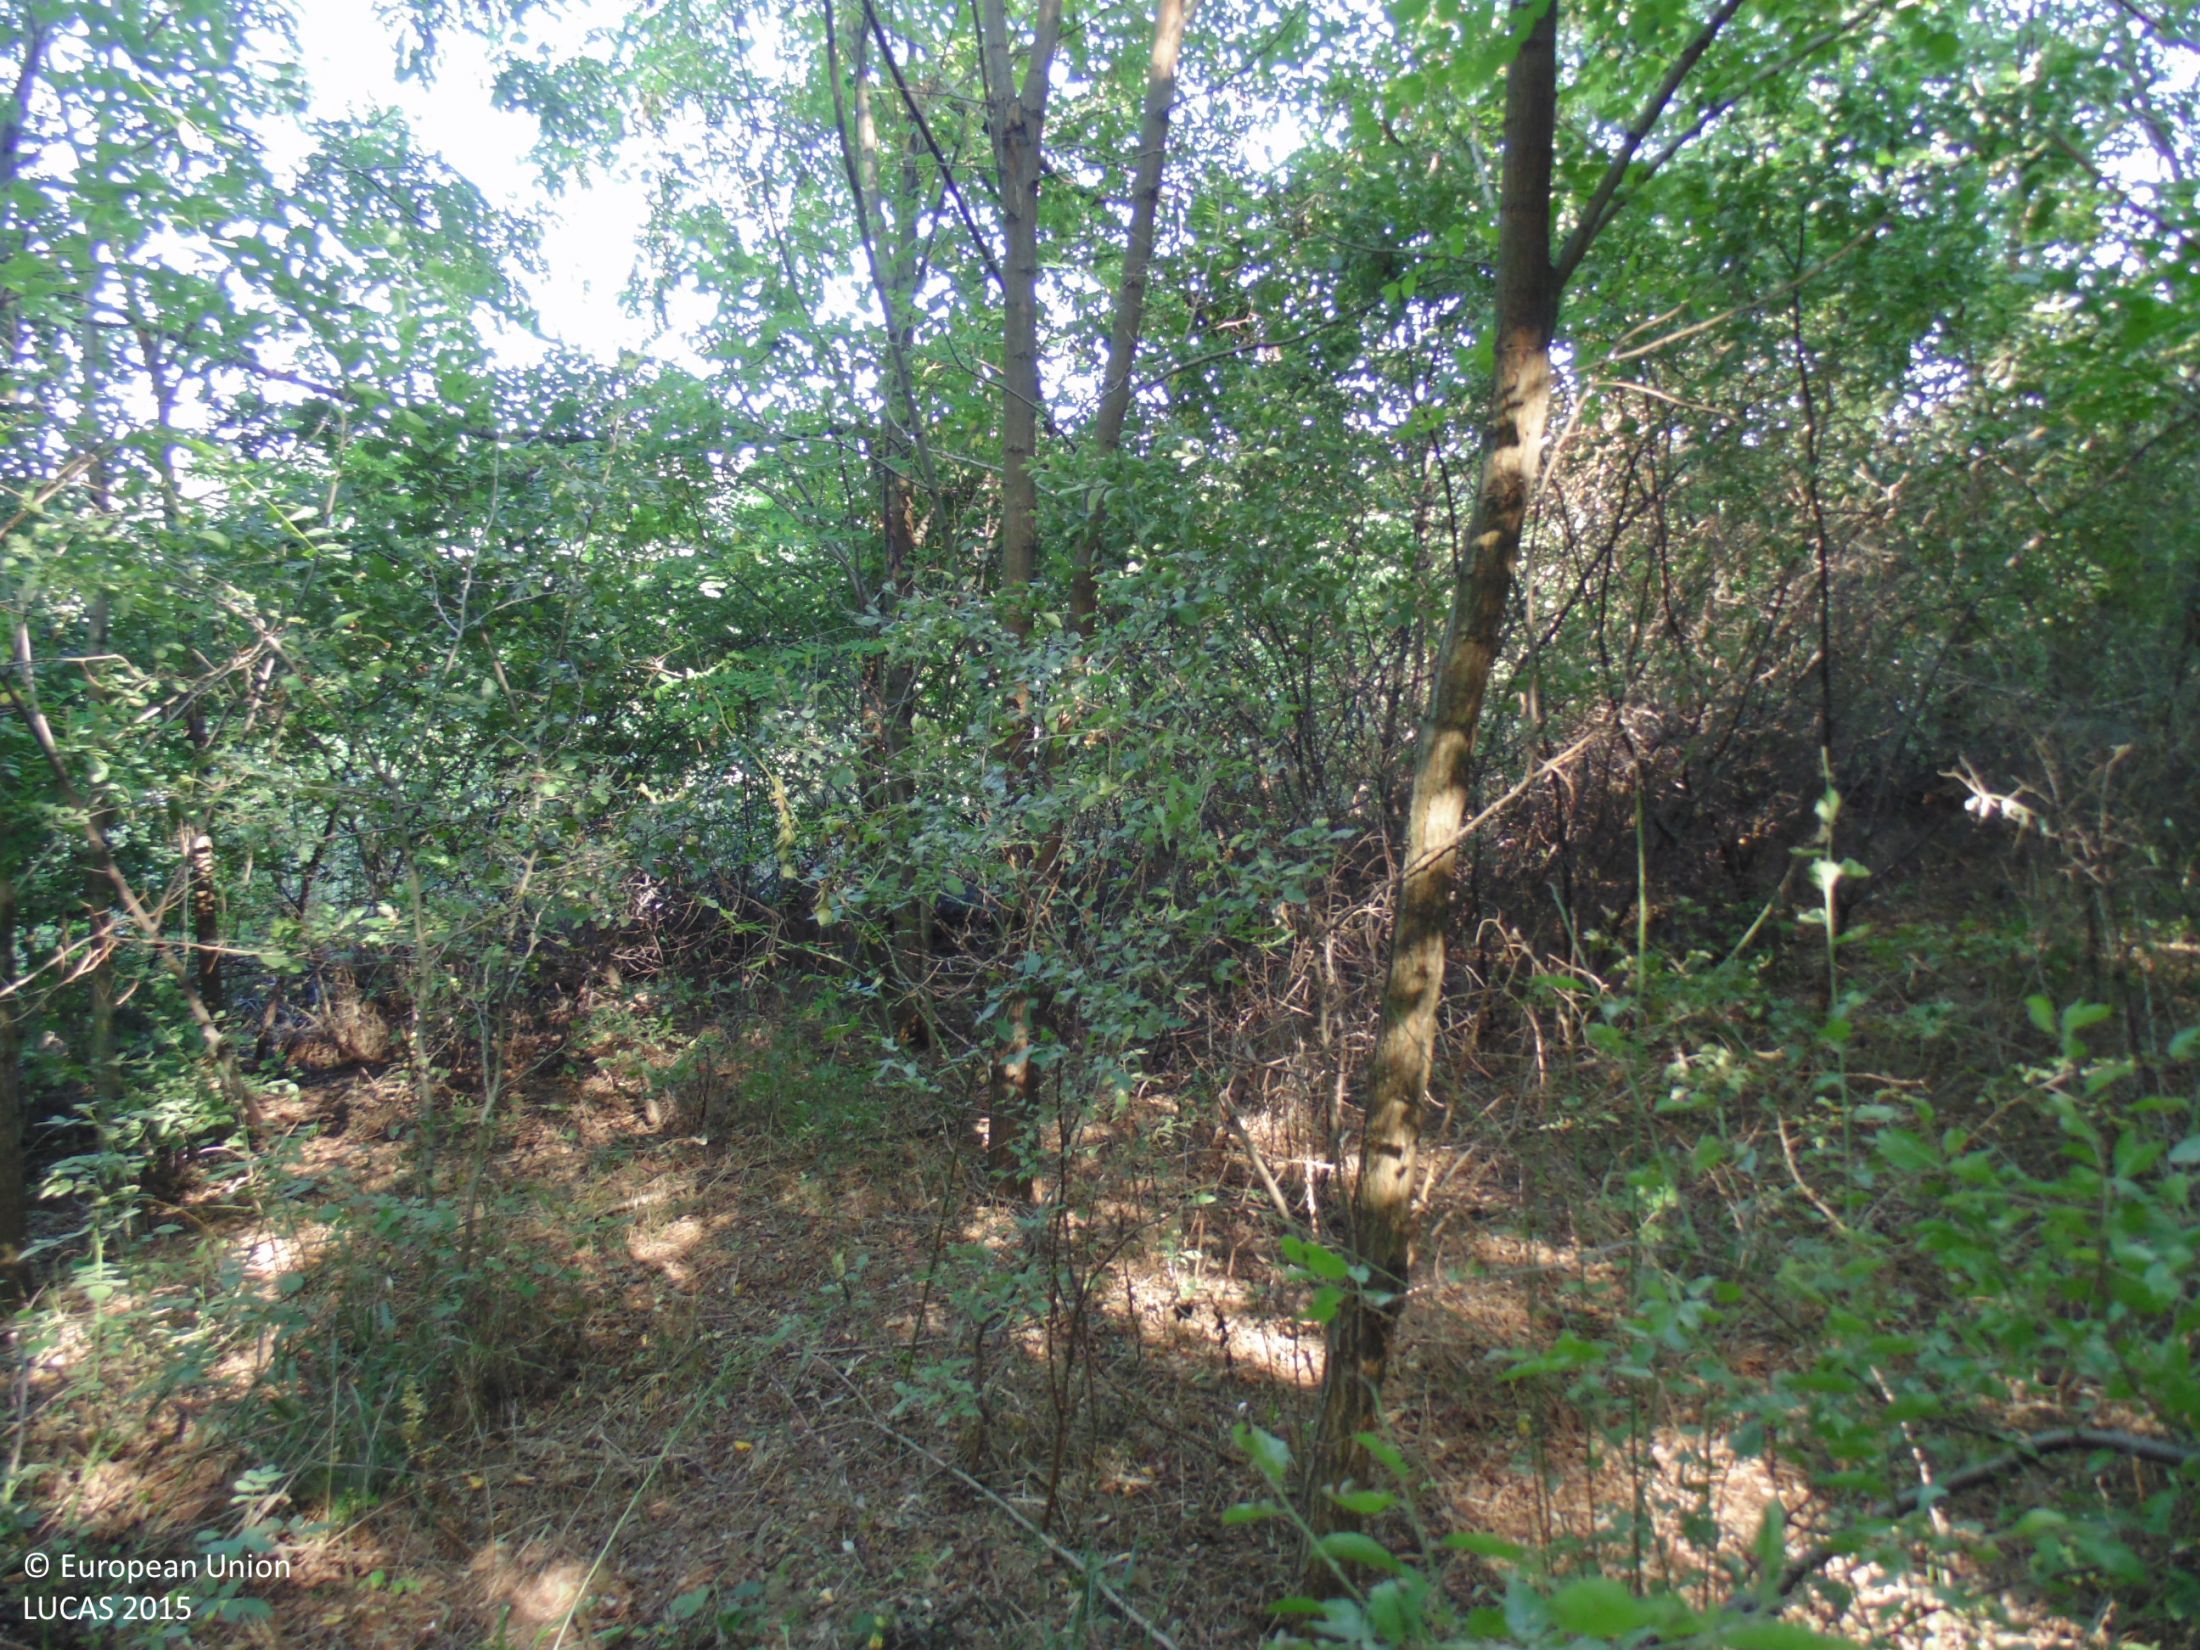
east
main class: Woodland
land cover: Broadleaved woodland
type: mesophytic deciduous forest
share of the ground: > 75 %
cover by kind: broadleaved forest trees 90 %, shrubs 5 %, unconsolidated bare surface 5 %
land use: Forestry
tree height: > 5 m
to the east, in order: Broadleaved woodland; Tracks; Shrubland without tree cover; Broadleaved woodland
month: August
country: BG
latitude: 43.9238
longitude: 27.3574
